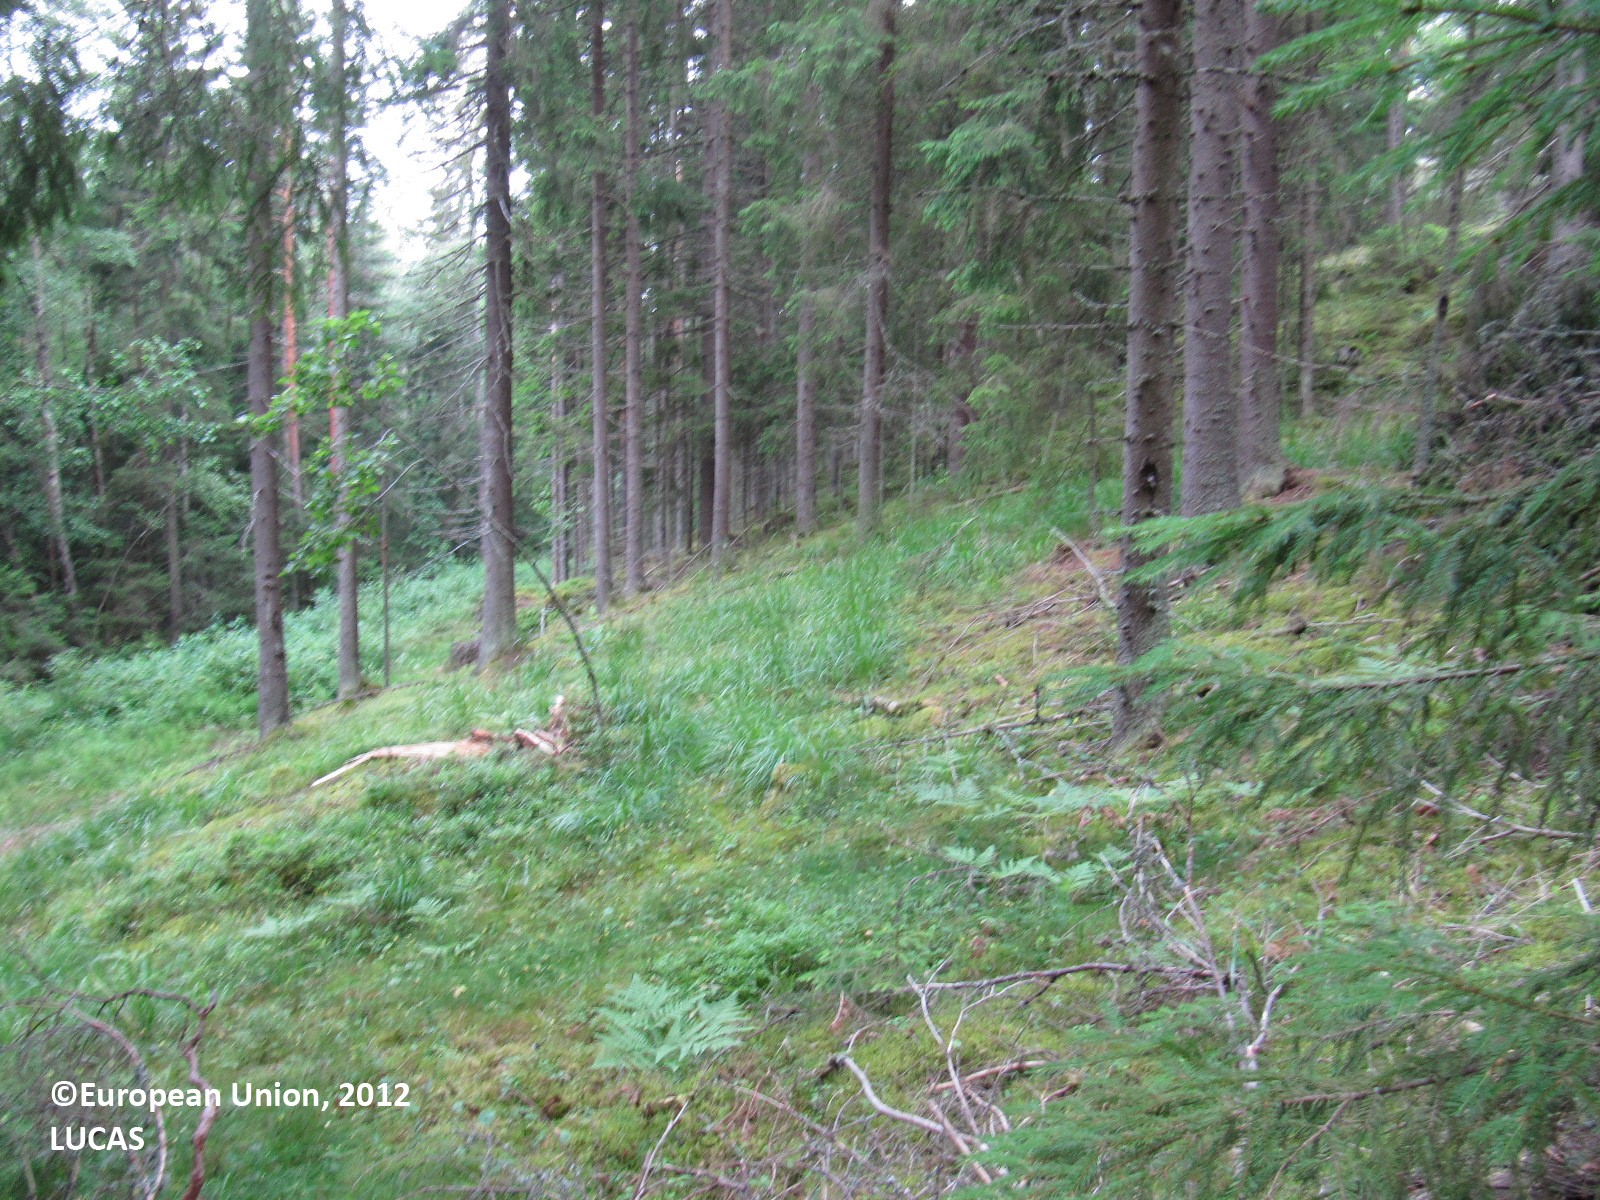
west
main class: Woodland
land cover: Spruce dominated coniferous woodland
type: boreal forest
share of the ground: 50 - 75 %
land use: Forestry
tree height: > 5 m
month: July
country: FI
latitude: 60.8000
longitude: 23.4051
